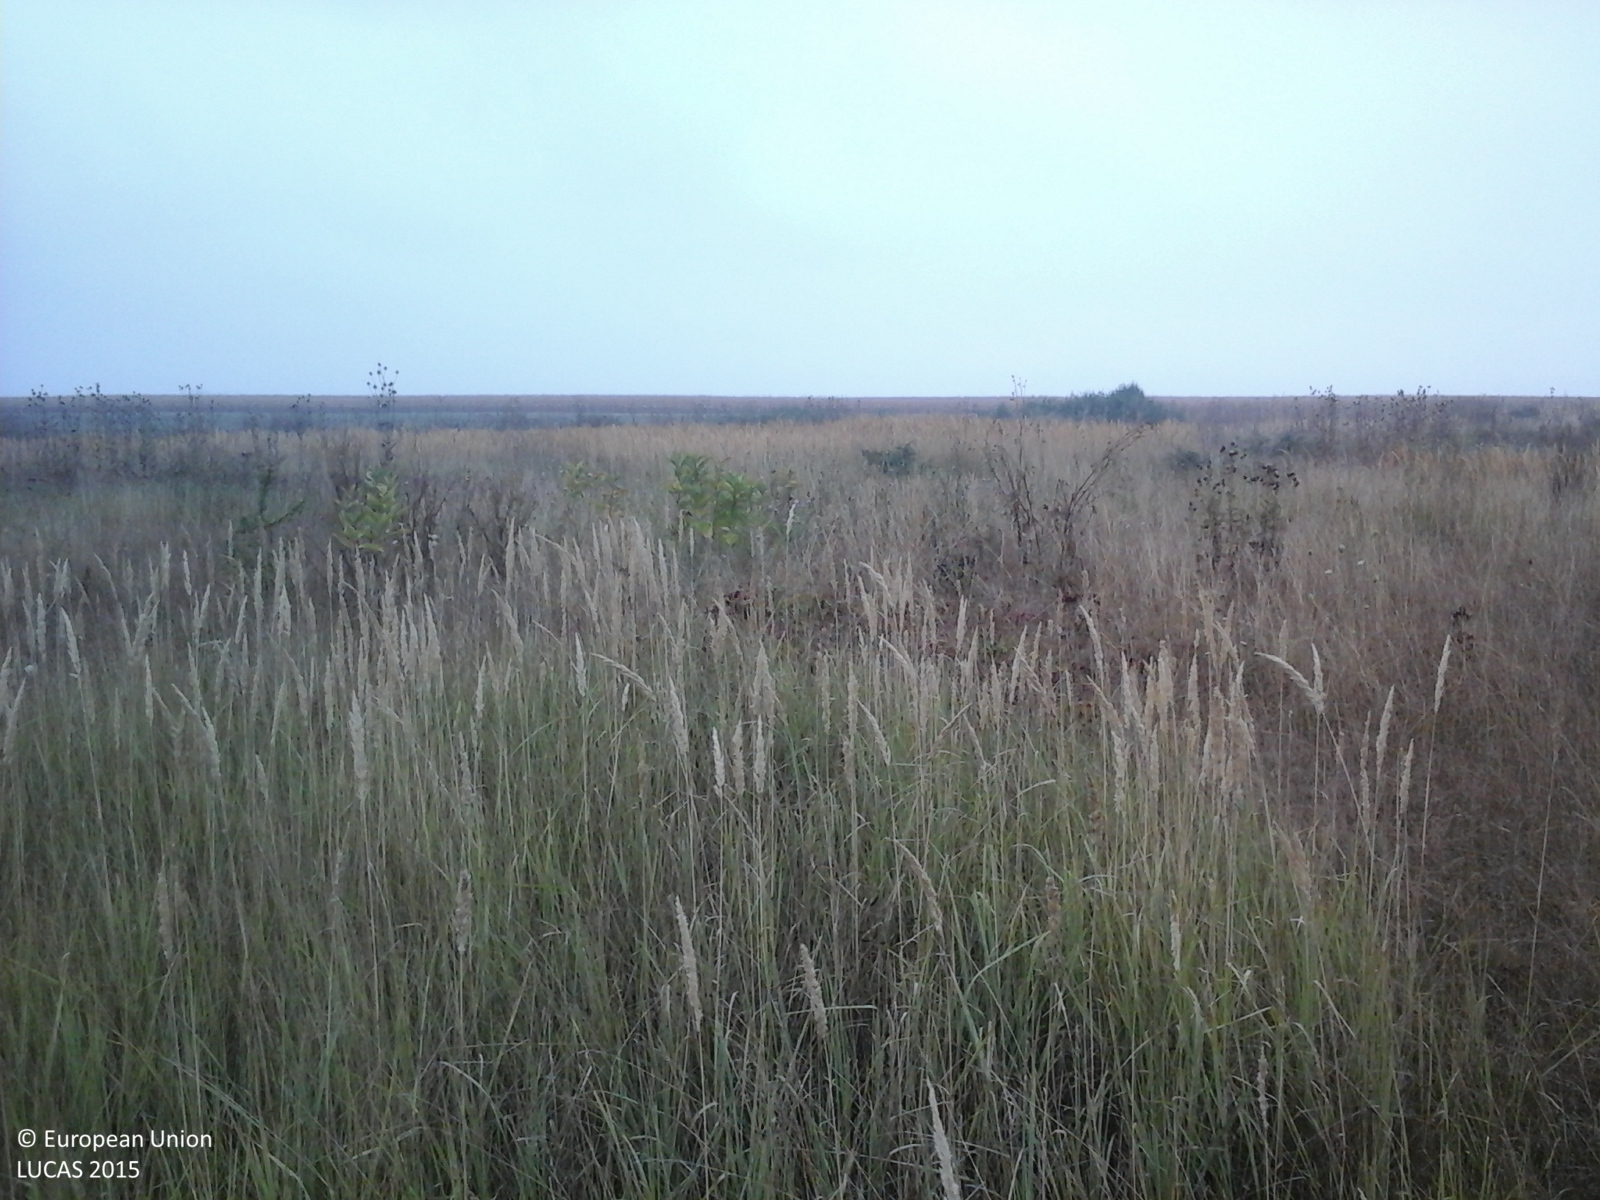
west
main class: Grassland
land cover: Spontaneously vegetated surfaces
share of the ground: > 75 %
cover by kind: herbaceous plants 100 %
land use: Fallow land
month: August
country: RO
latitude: 46.0701
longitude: 20.8495
